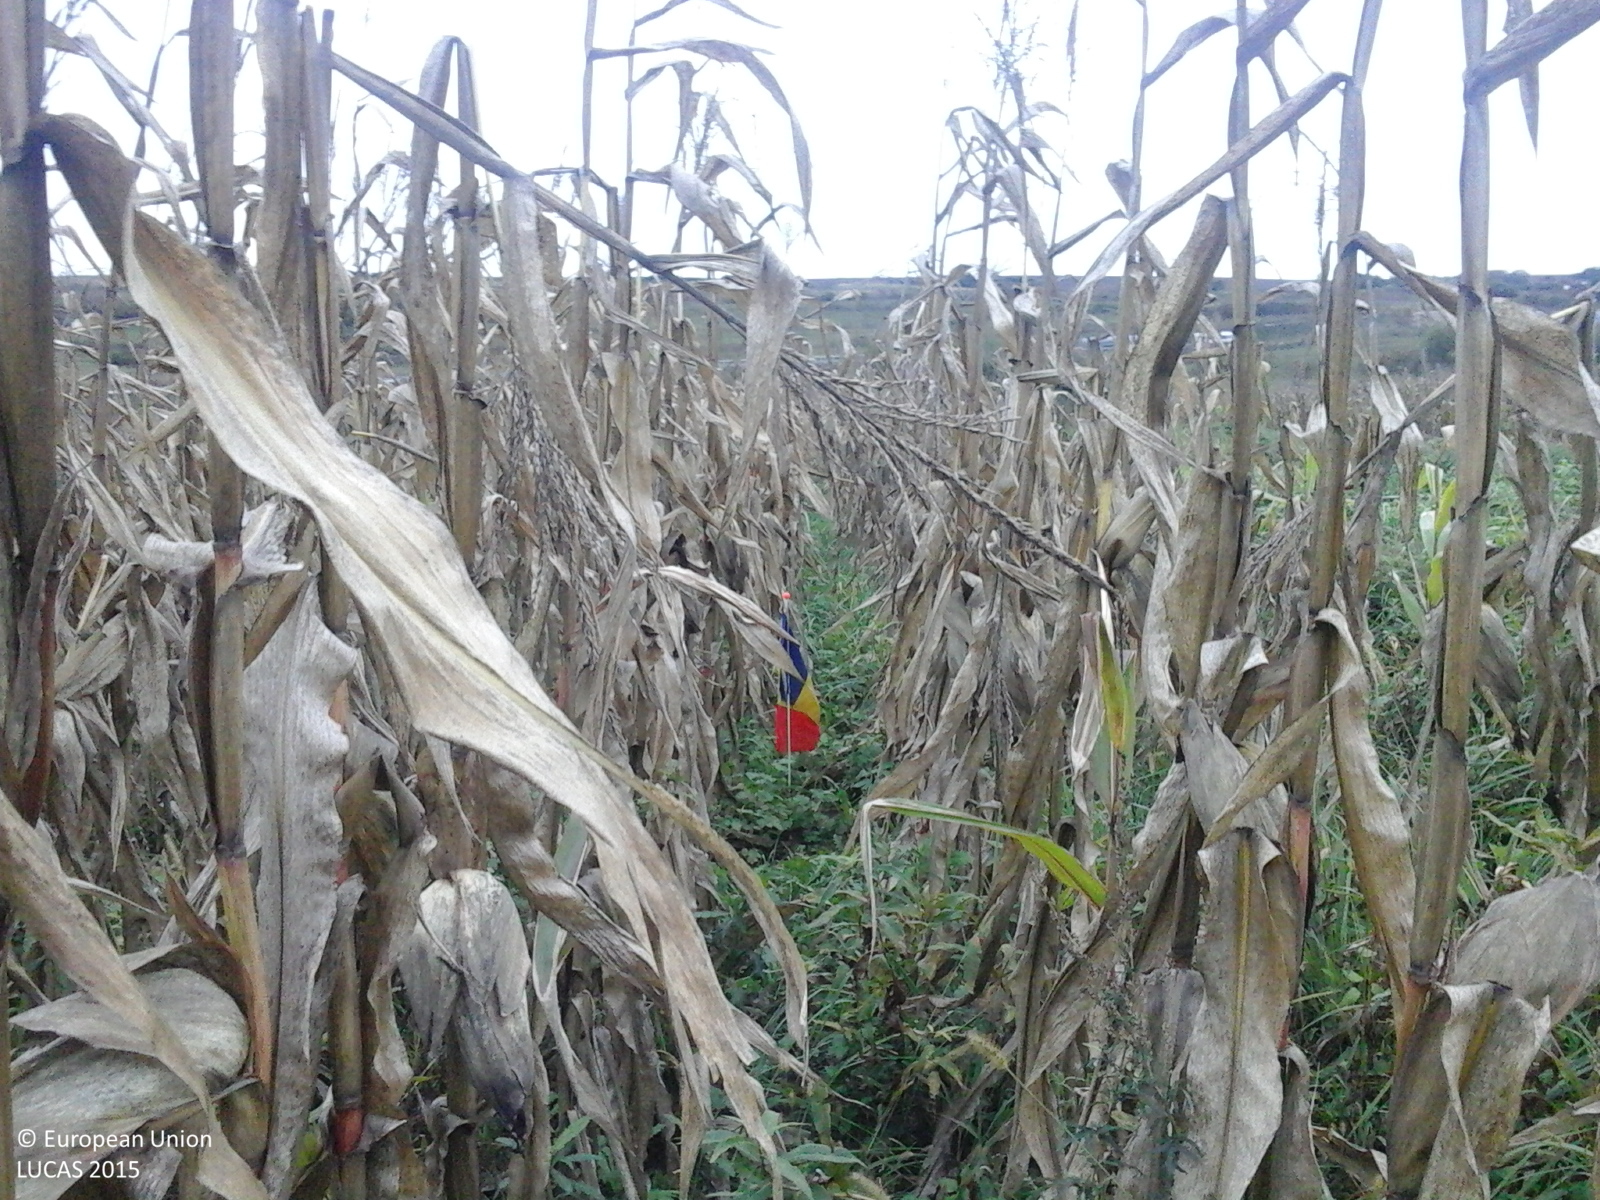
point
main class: Cropland
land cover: Maize
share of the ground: > 75 %
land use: Agriculture (excluding fallow land and kitchen gardens)
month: September
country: RO
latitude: 45.9249
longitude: 23.6712
